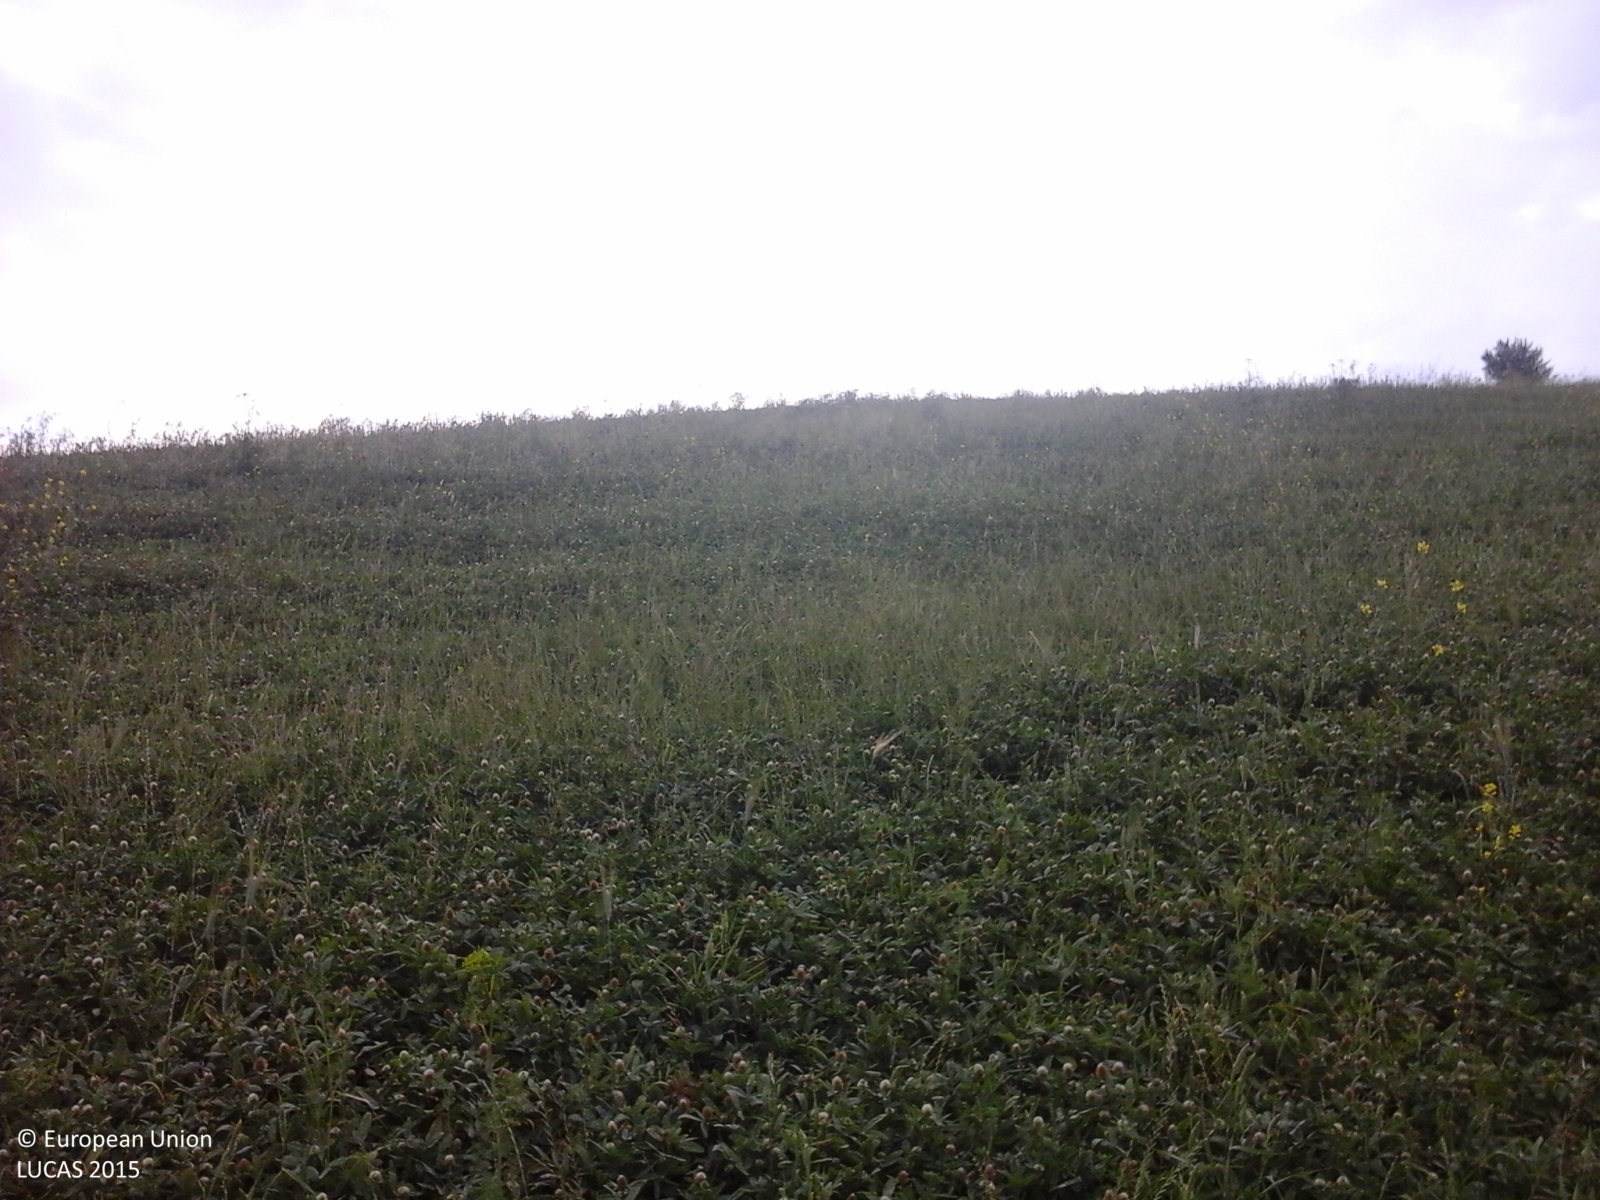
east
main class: Cropland
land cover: Durum wheat
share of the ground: > 75 %
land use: Agriculture (excluding fallow land and kitchen gardens)
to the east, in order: Durum wheat; Ditches and canals; Durum wheat; Grassland without tree/shrub cover; Ditches and canals; Grass margins; Temporary grasslands
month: May
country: IT
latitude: 37.7371
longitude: 13.9769
